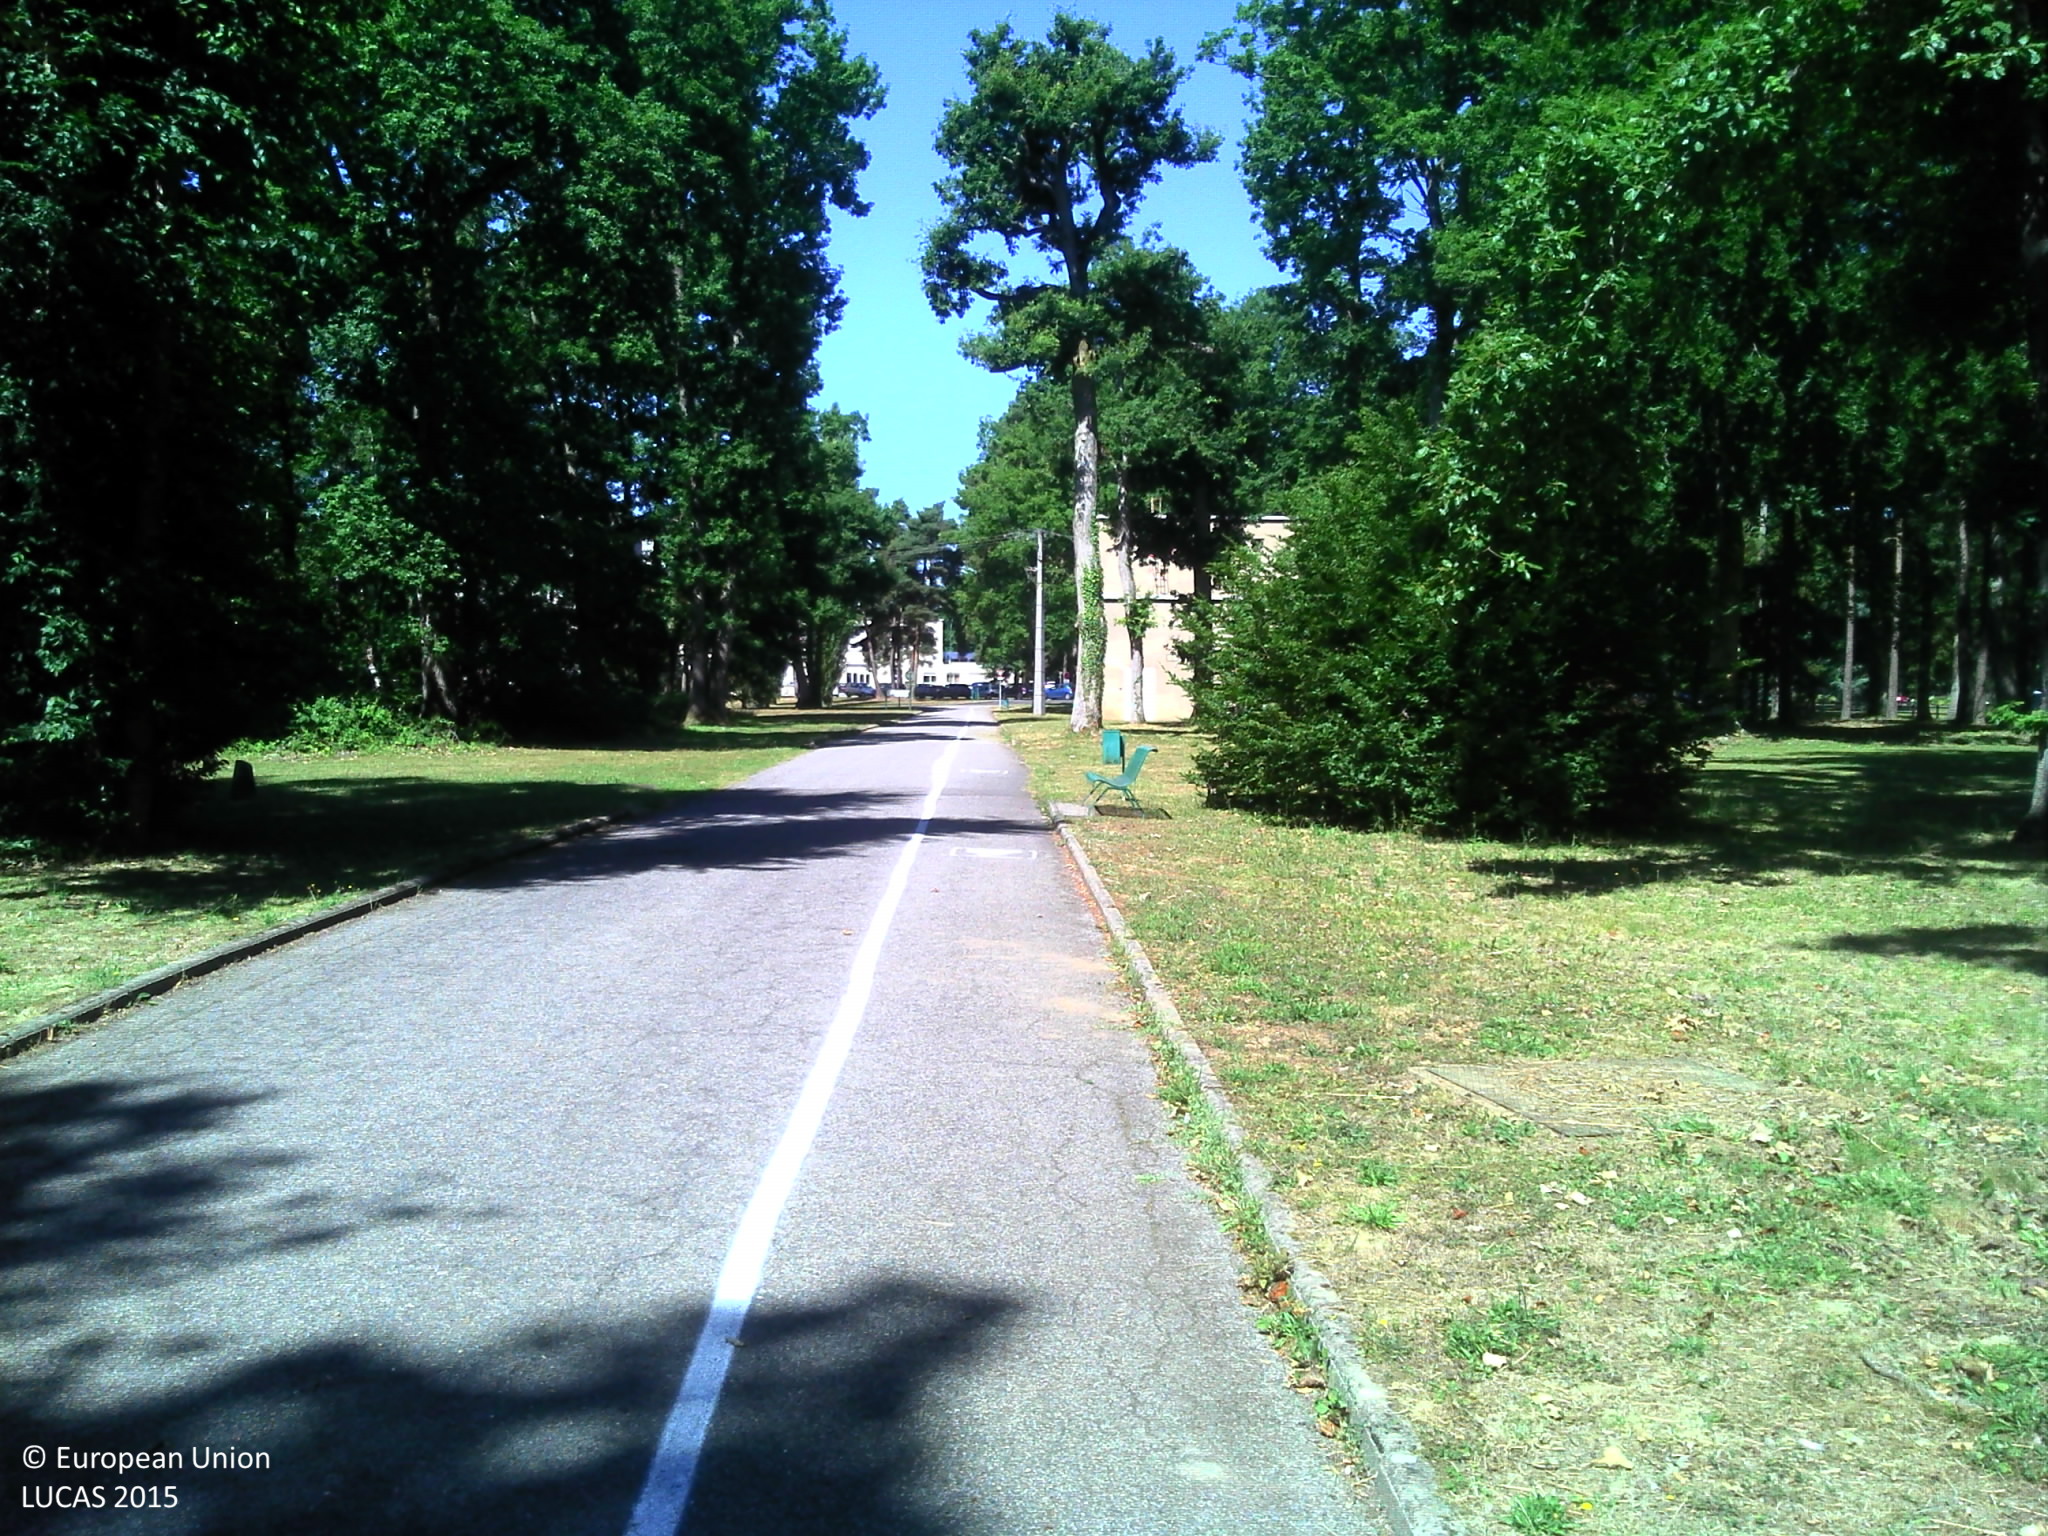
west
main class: Woodland
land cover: Broadleaved woodland
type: mesophytic deciduous forest
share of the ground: > 75 %
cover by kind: broadleaved forest trees 80 %, herbaceous plants 20 %
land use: Community services
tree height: > 5 m
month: June
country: FR
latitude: 49.0017
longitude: 1.0803
